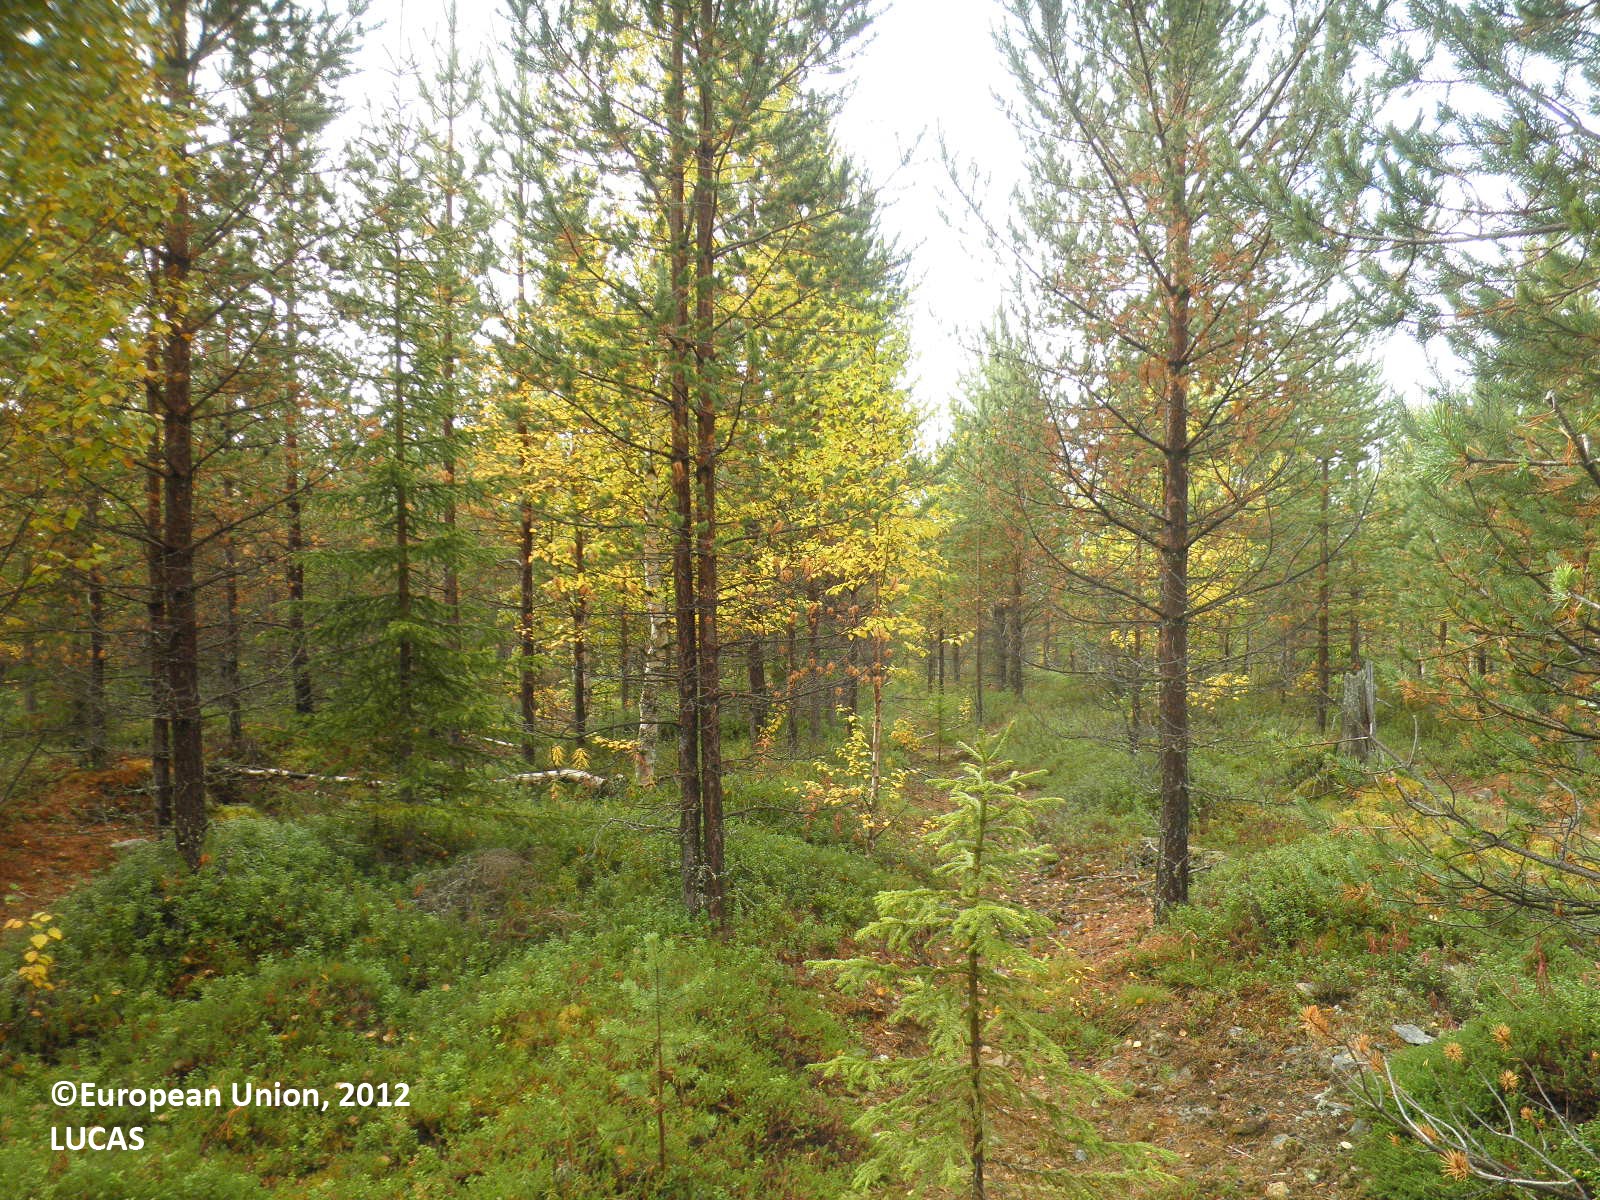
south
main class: Woodland
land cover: Pine dominated coniferous woodland
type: boreal forest
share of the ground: 50 - 75 %
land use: Forestry
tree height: > 5 m
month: September
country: FI
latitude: 67.2414
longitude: 28.1675
